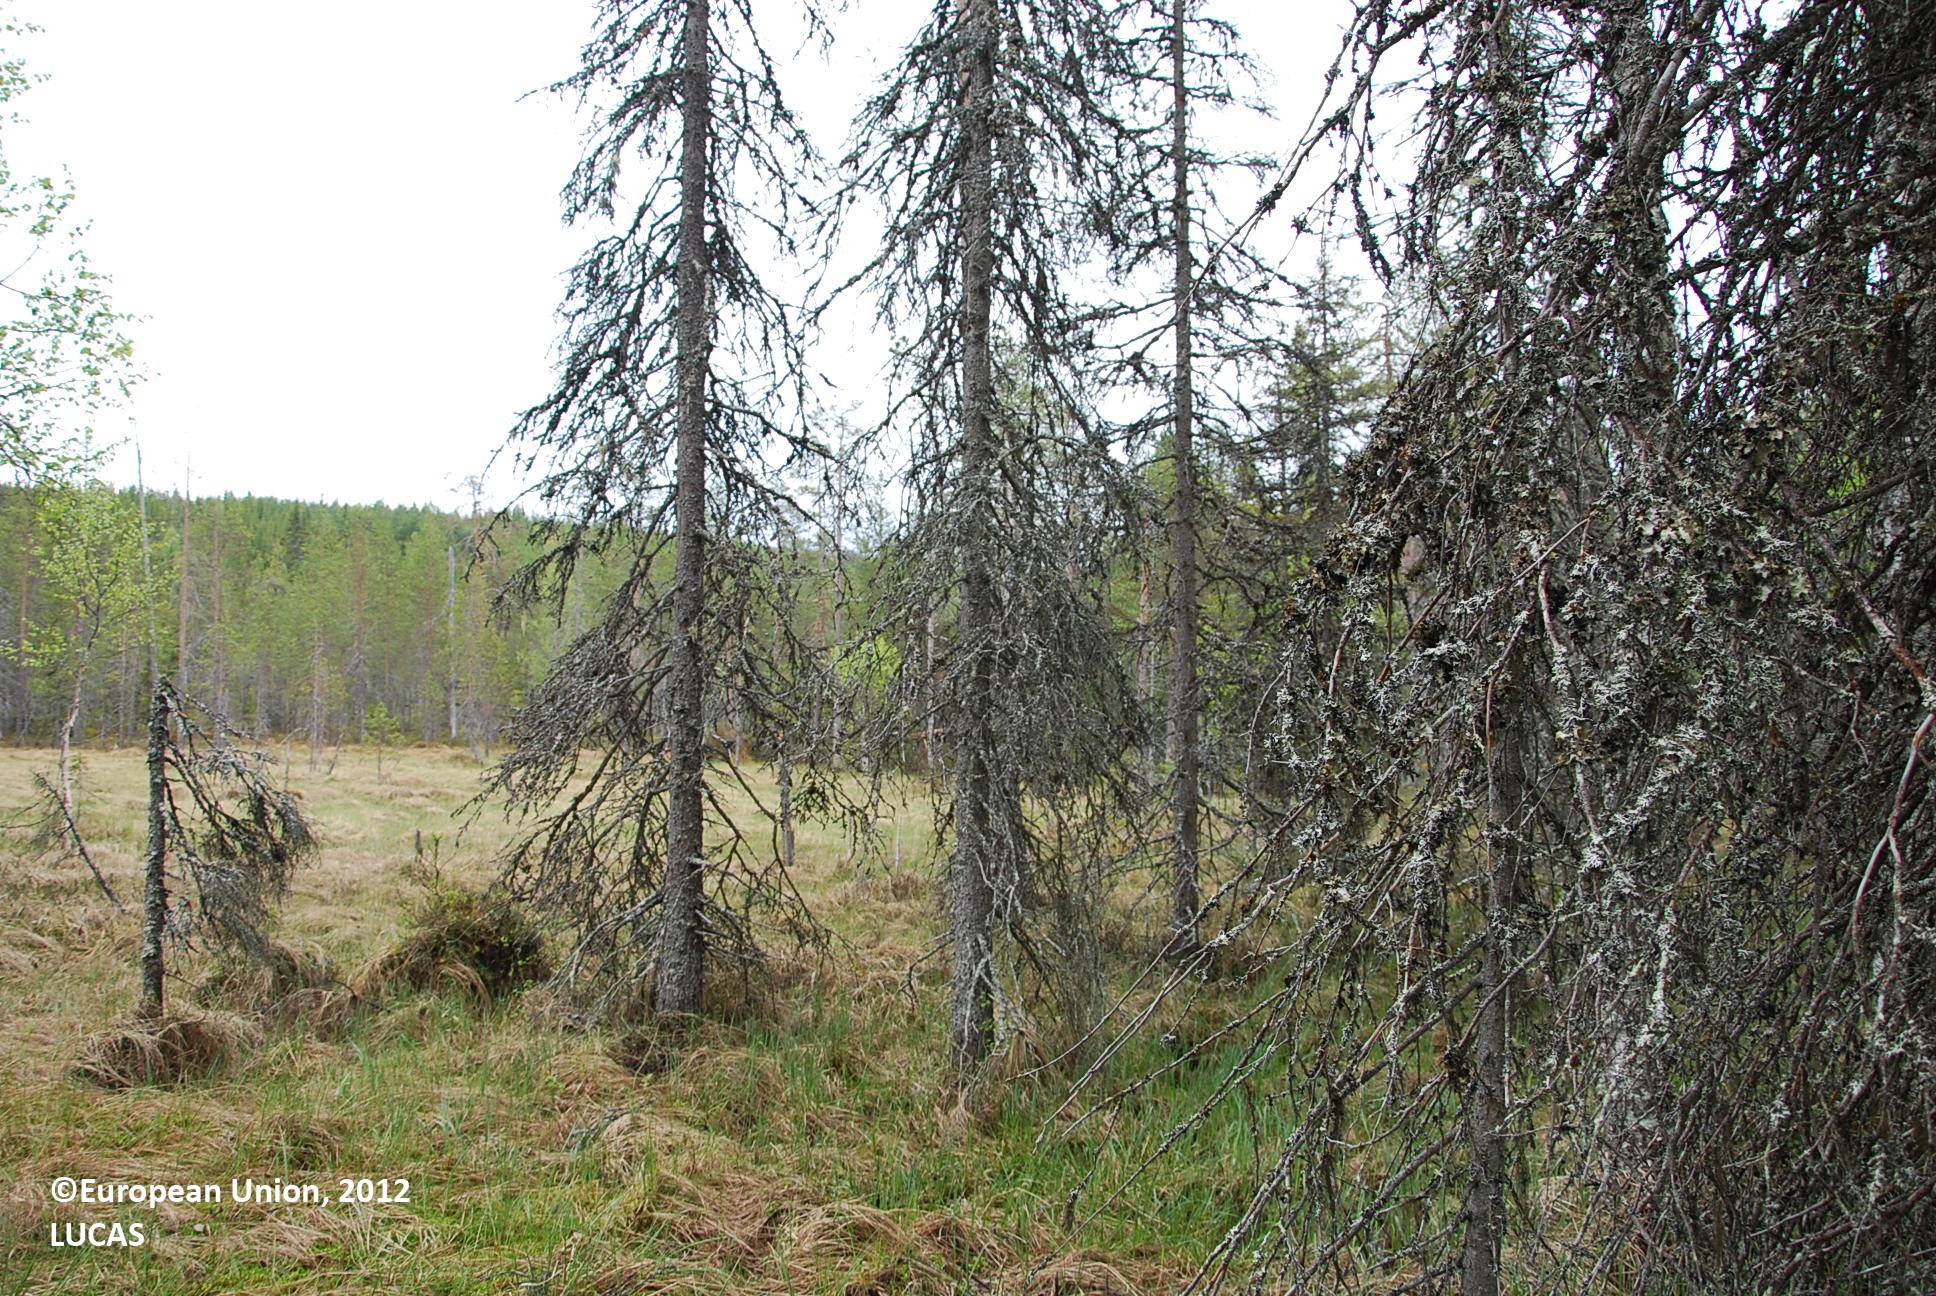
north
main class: Woodland
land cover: Other mixed woodland
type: boreal forest
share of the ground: 50 - 75 %
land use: Forestry
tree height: > 5 m
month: June
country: FI
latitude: 66.2462
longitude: 27.4936
